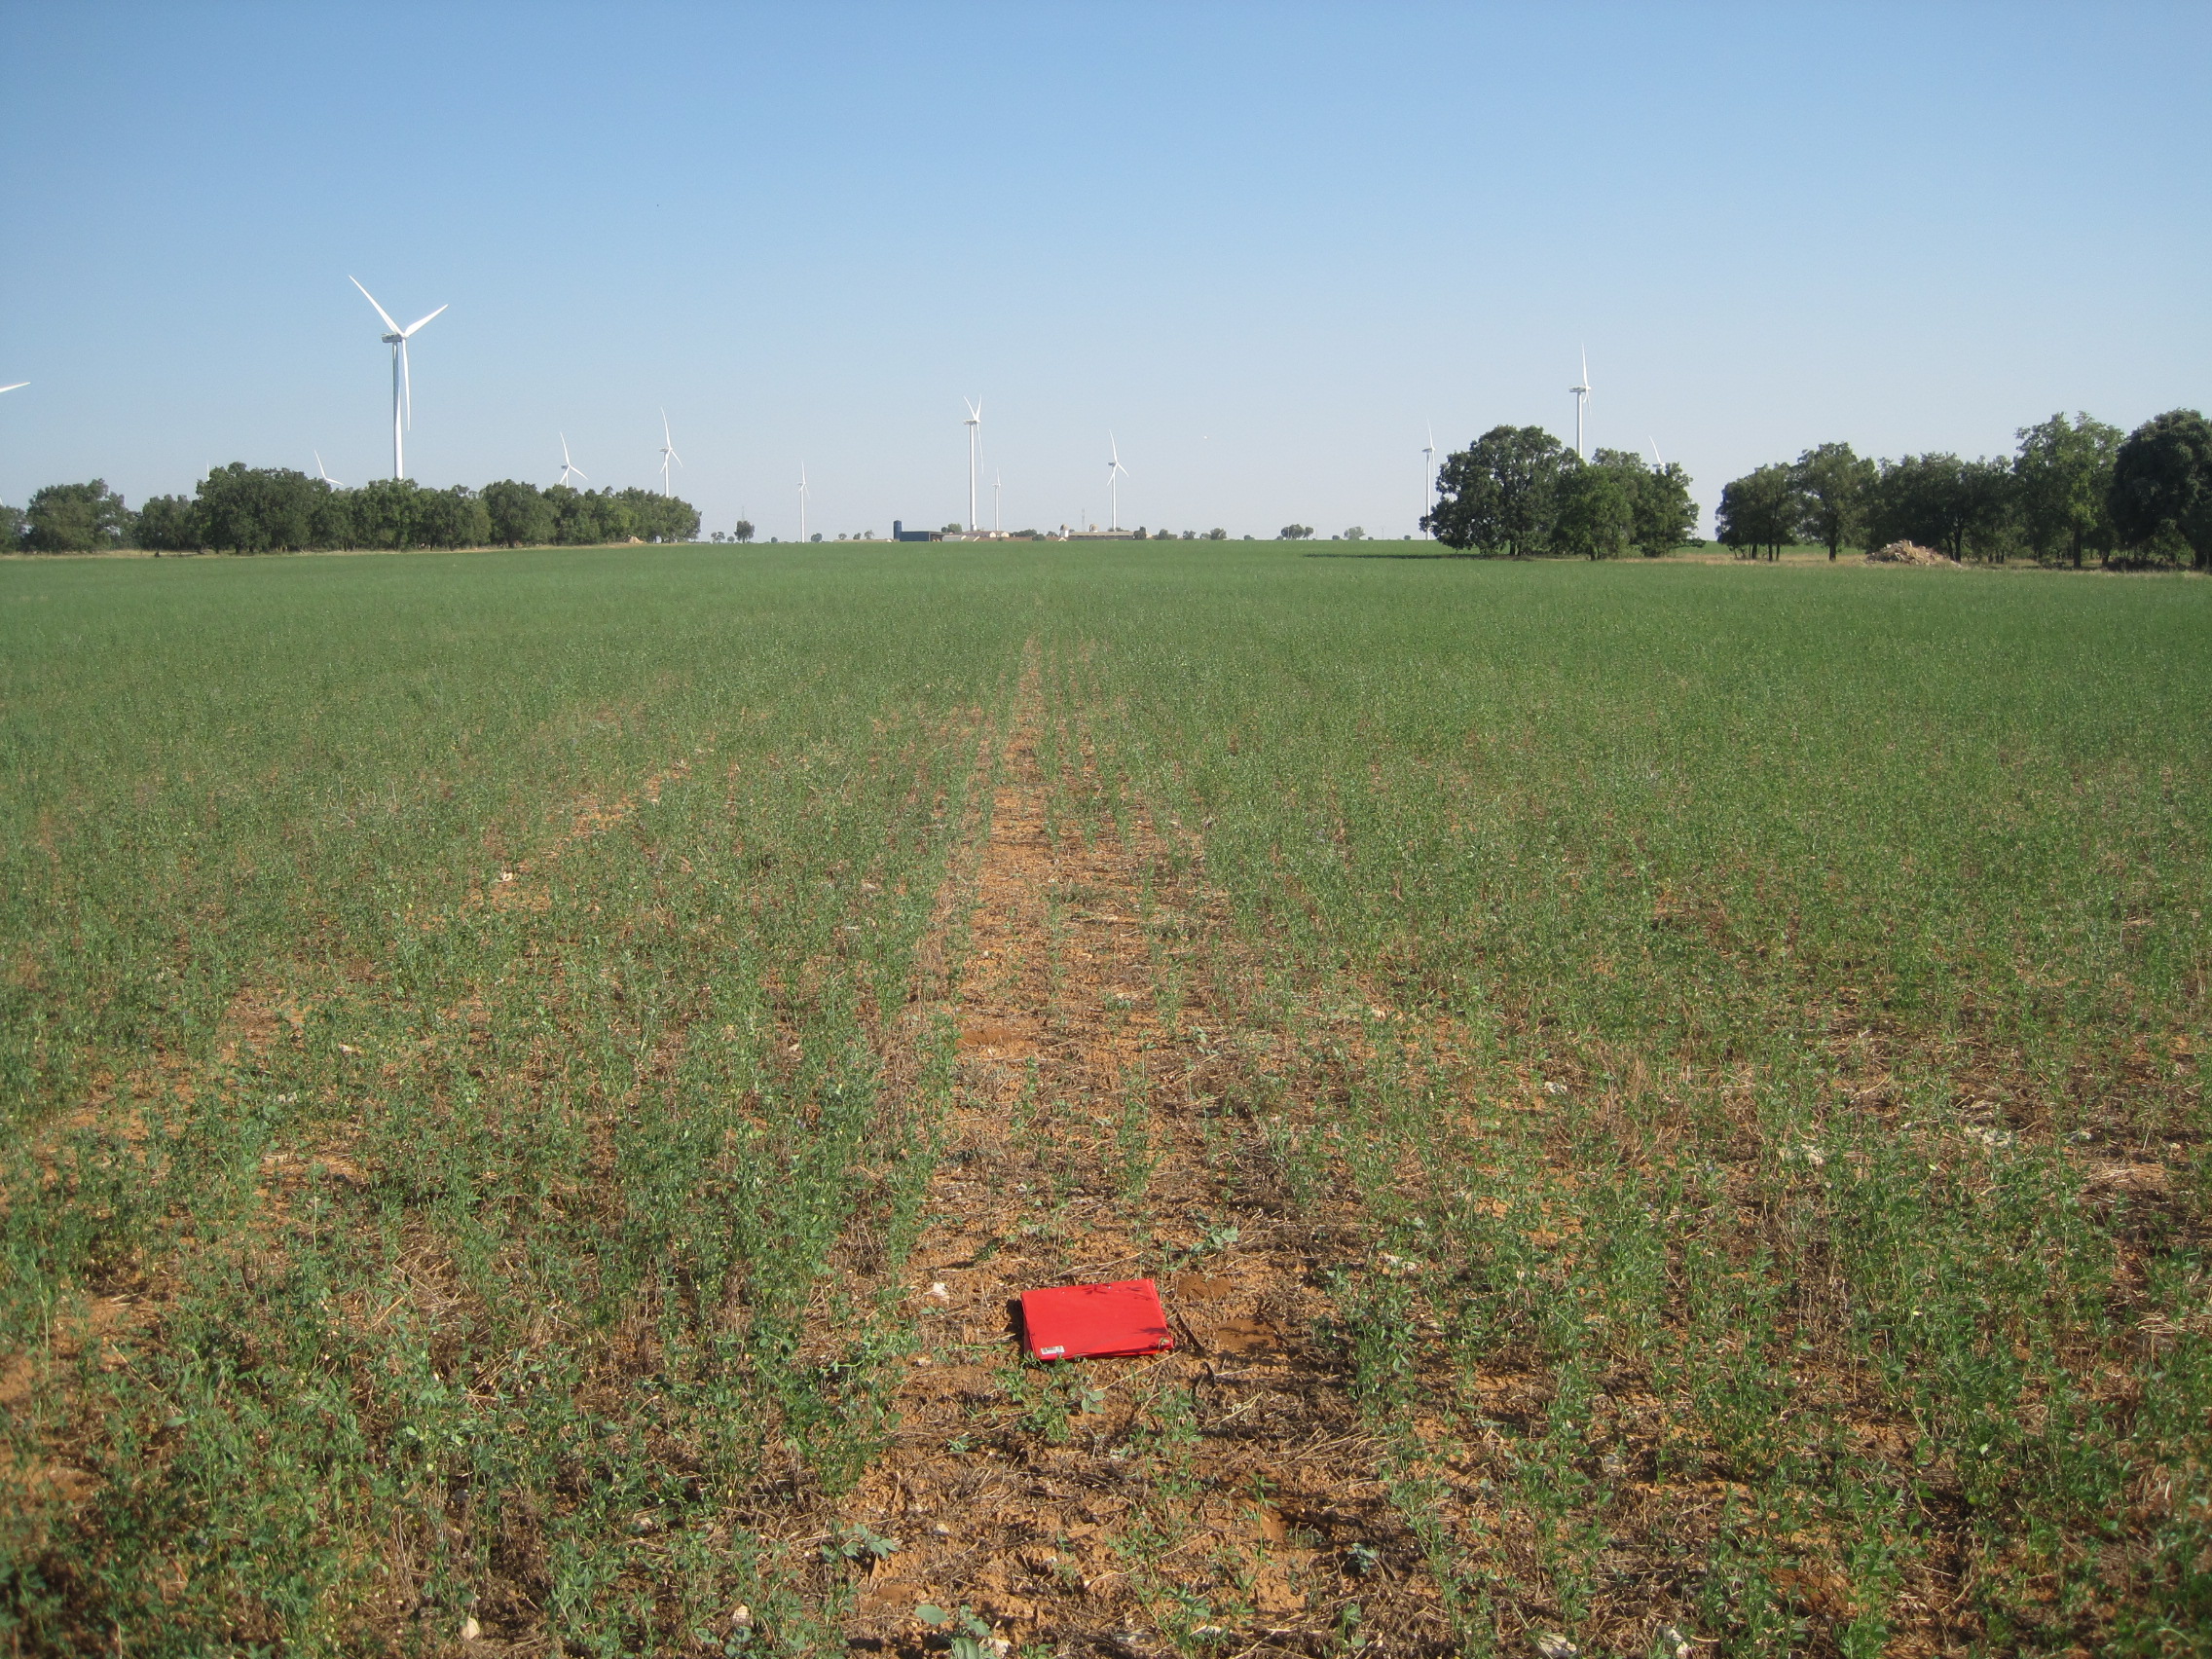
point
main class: Cropland
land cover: Lucerne
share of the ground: > 75 %
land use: Agriculture (excluding fallow land and kitchen gardens)
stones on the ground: 25 - 50 %
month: July
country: ES
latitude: 41.8773
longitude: -4.7611
